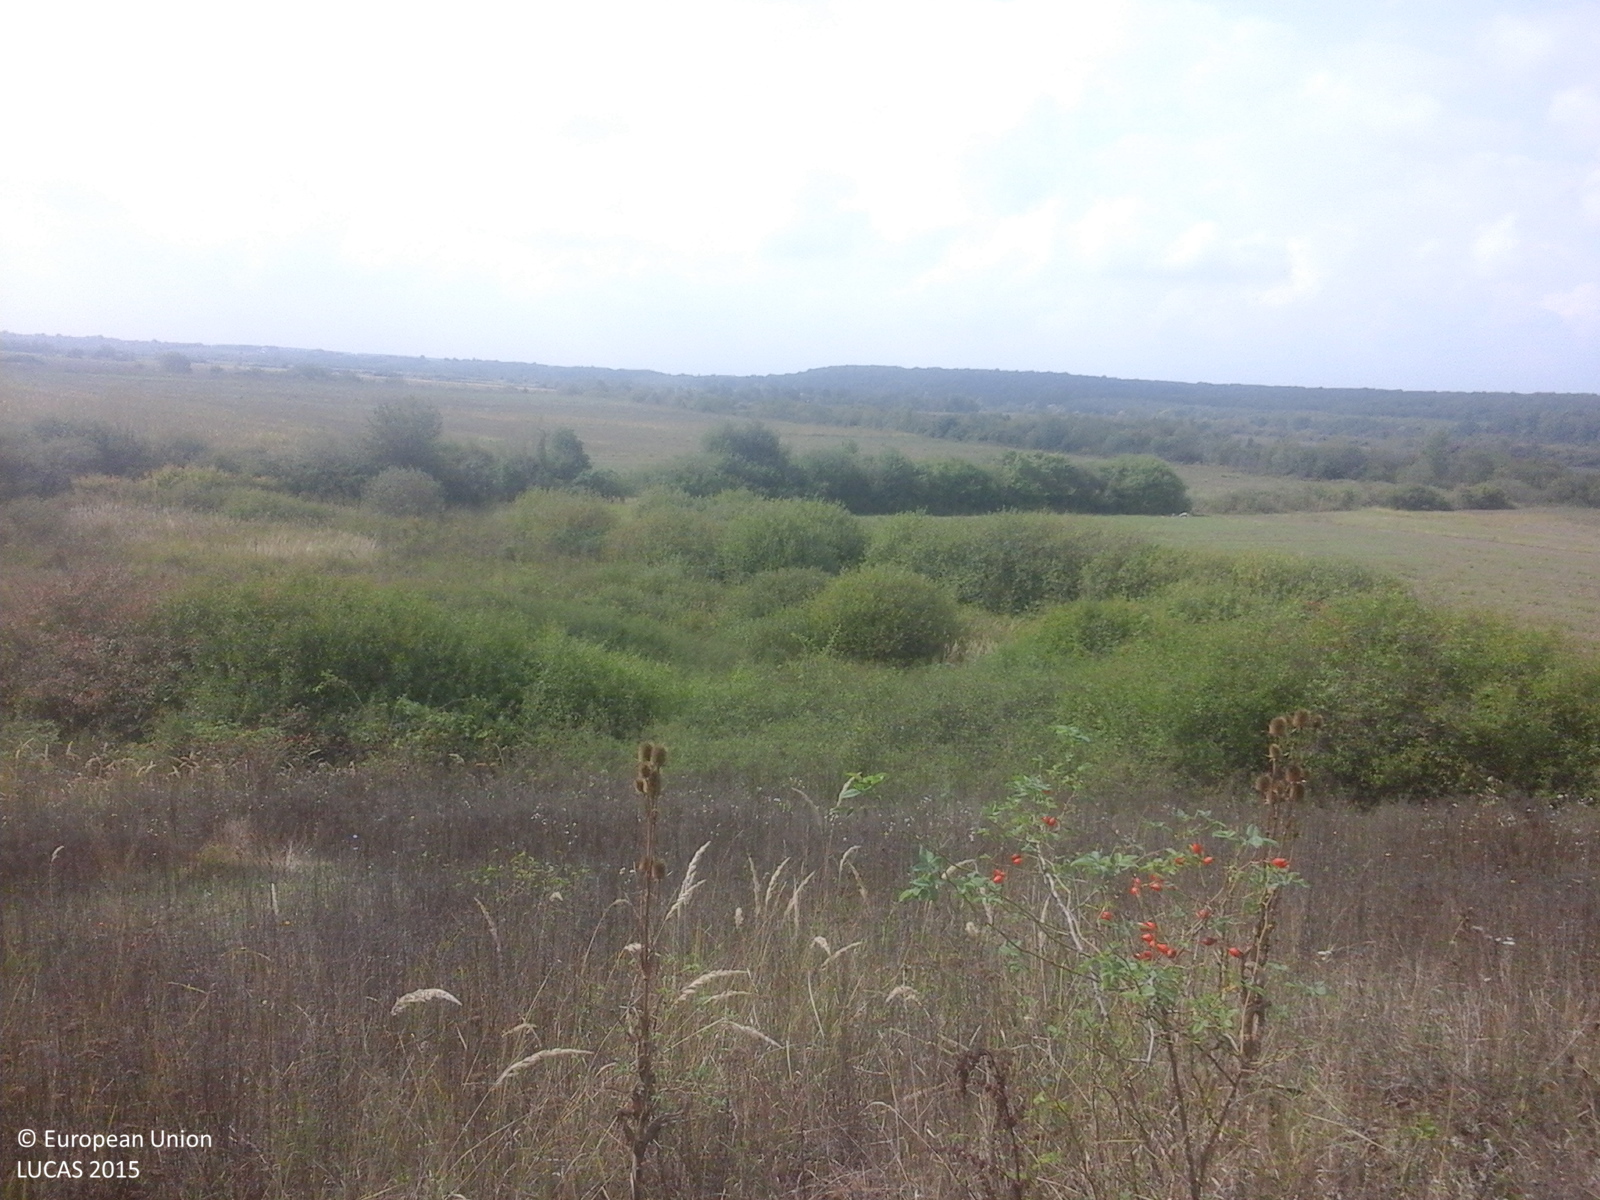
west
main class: Grassland
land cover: Spontaneously vegetated surfaces
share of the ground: > 75 %
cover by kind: herbaceous plants 100 %
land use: Fallow land
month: September
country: RO
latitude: 46.8444
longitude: 21.9390
